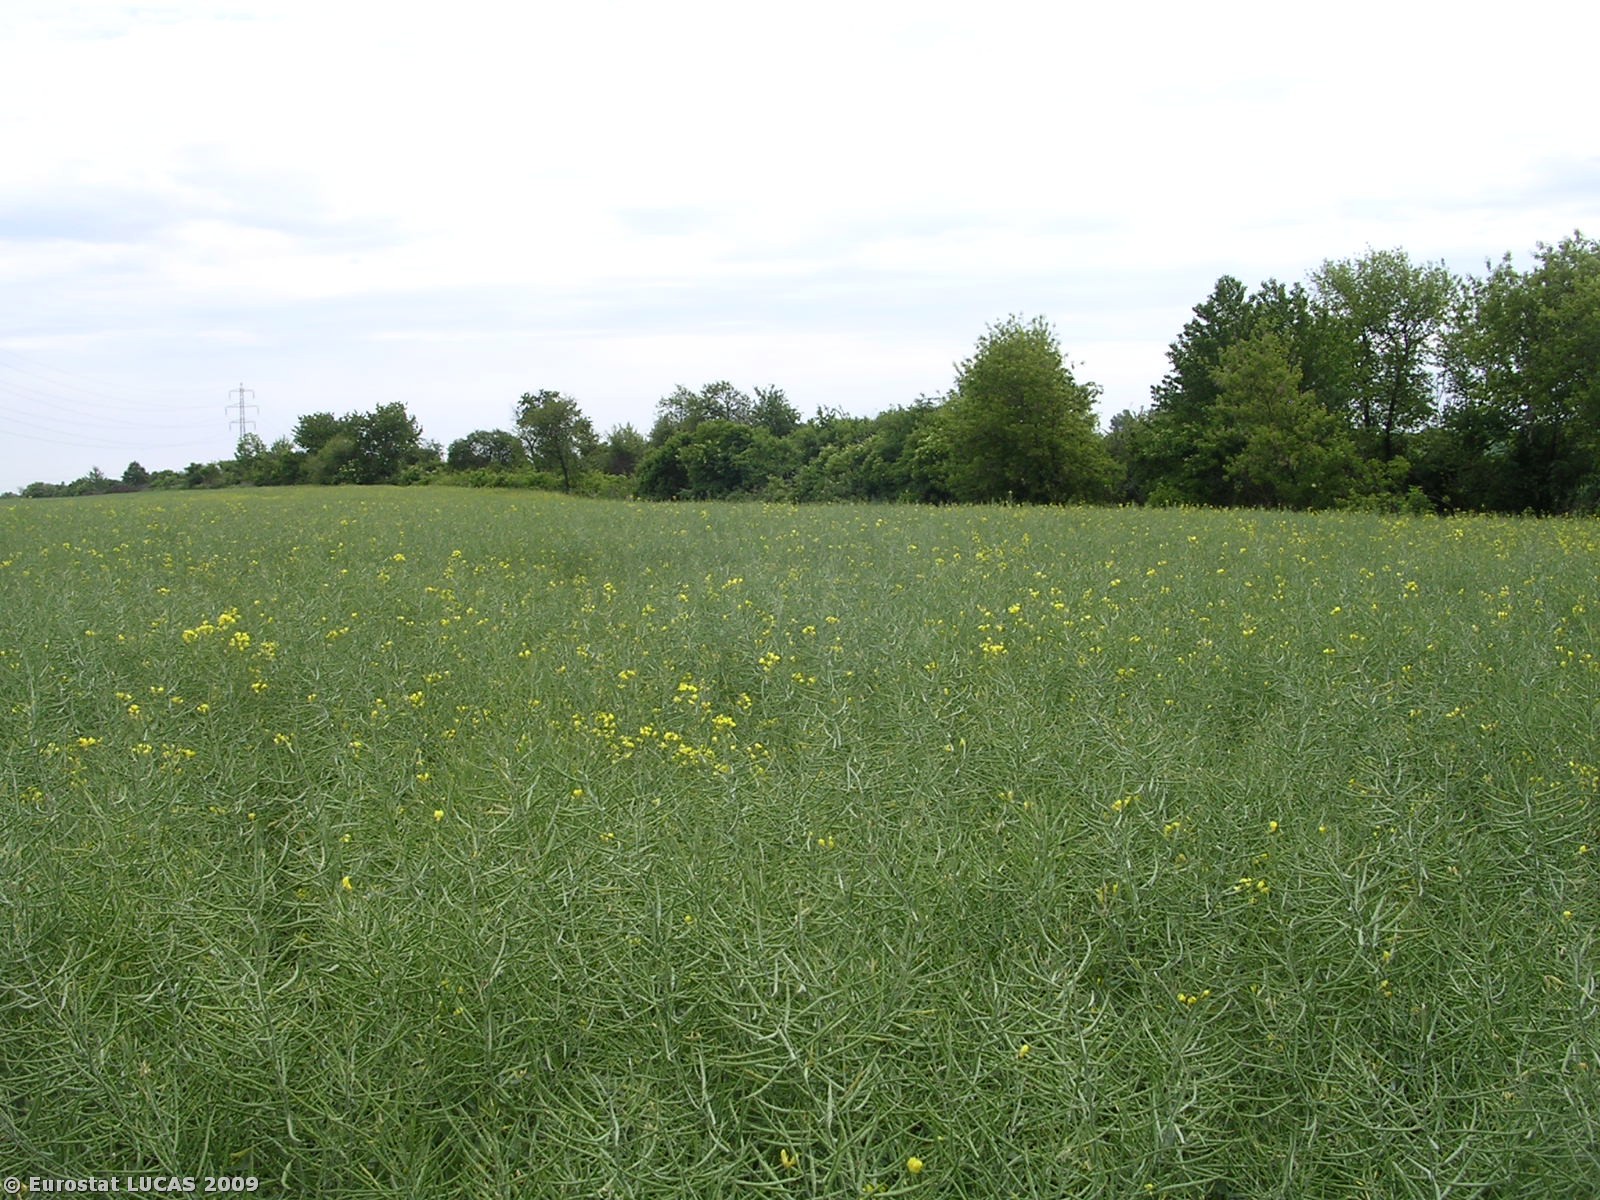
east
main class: Cropland
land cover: Rape and turnip rape
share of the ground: > 75 %
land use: Agriculture (excluding fallow land and kitchen gardens)
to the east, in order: Rape and turnip rape; Broadleaved woodland; Paved roads, cycling and walking lanes; Broadleaved woodland; Common wheat
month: May
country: CZ
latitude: 50.1598
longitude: 14.6913
